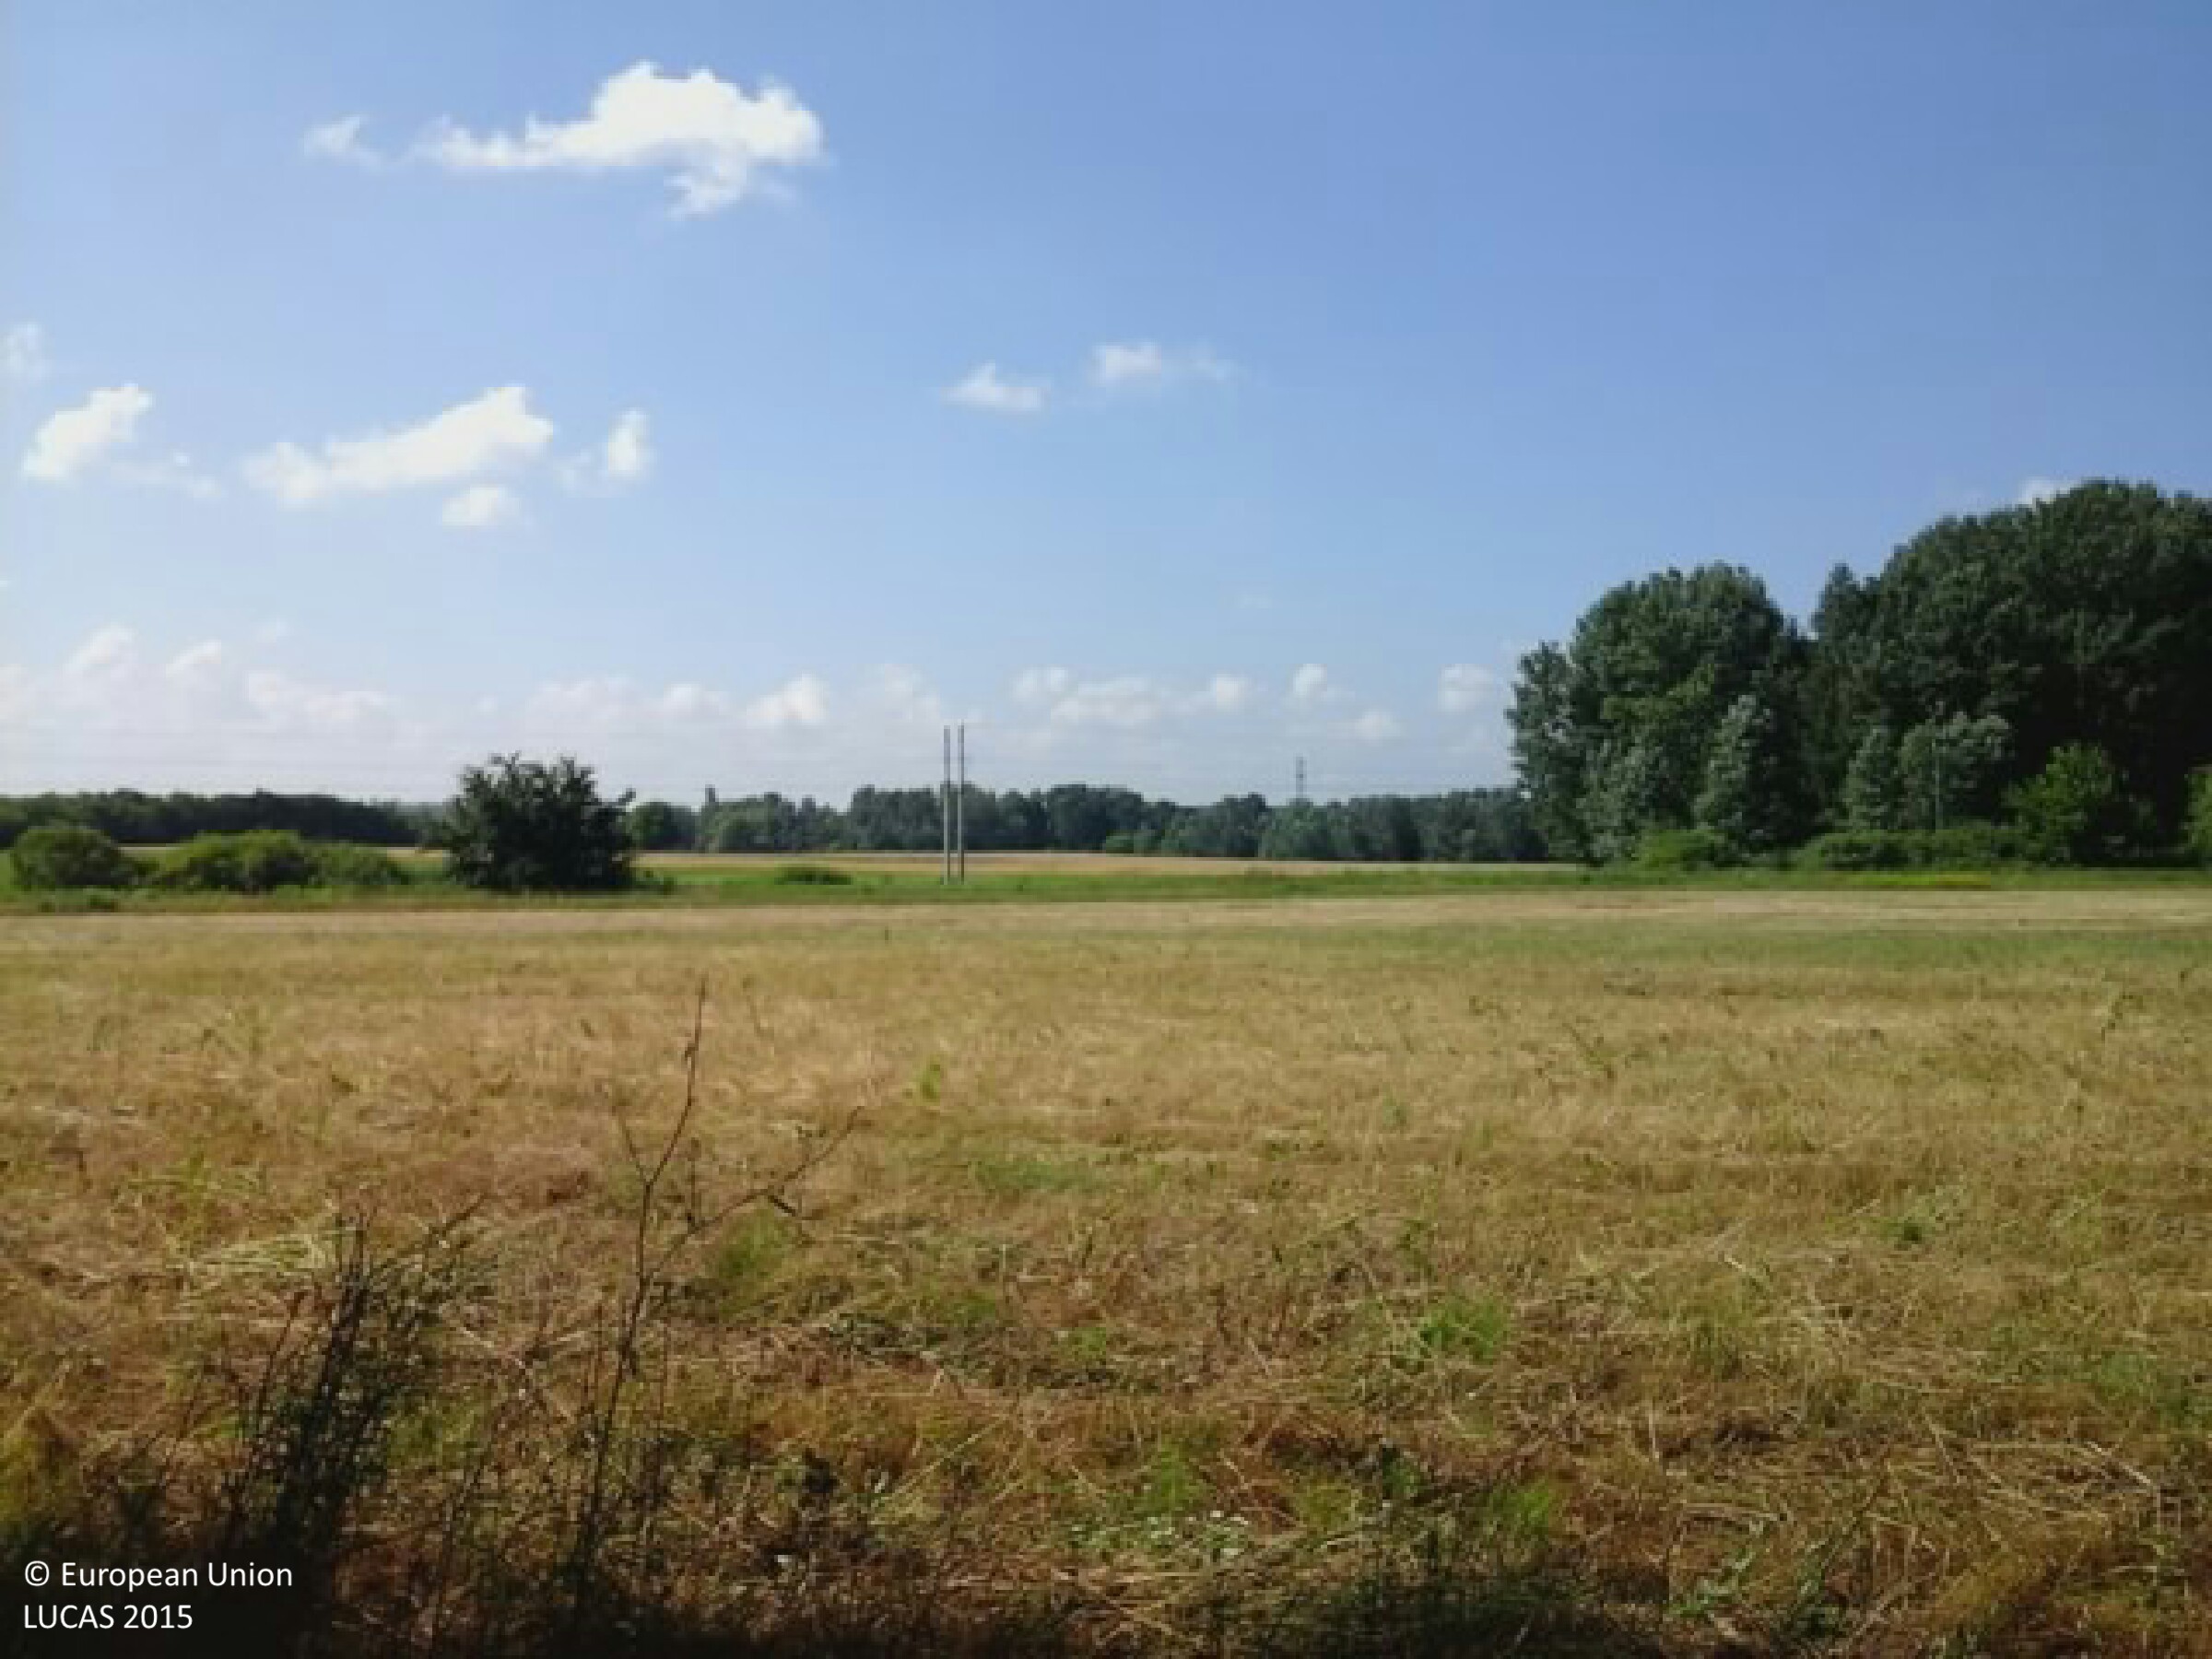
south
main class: Woodland
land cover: Broadleaved woodland
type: exotic forest
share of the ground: > 75 %
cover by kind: broadleaved forest trees 90 %, shrubs 10 %
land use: Forestry
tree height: > 5 m
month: June
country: HU
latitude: 47.6353
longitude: 19.2432
